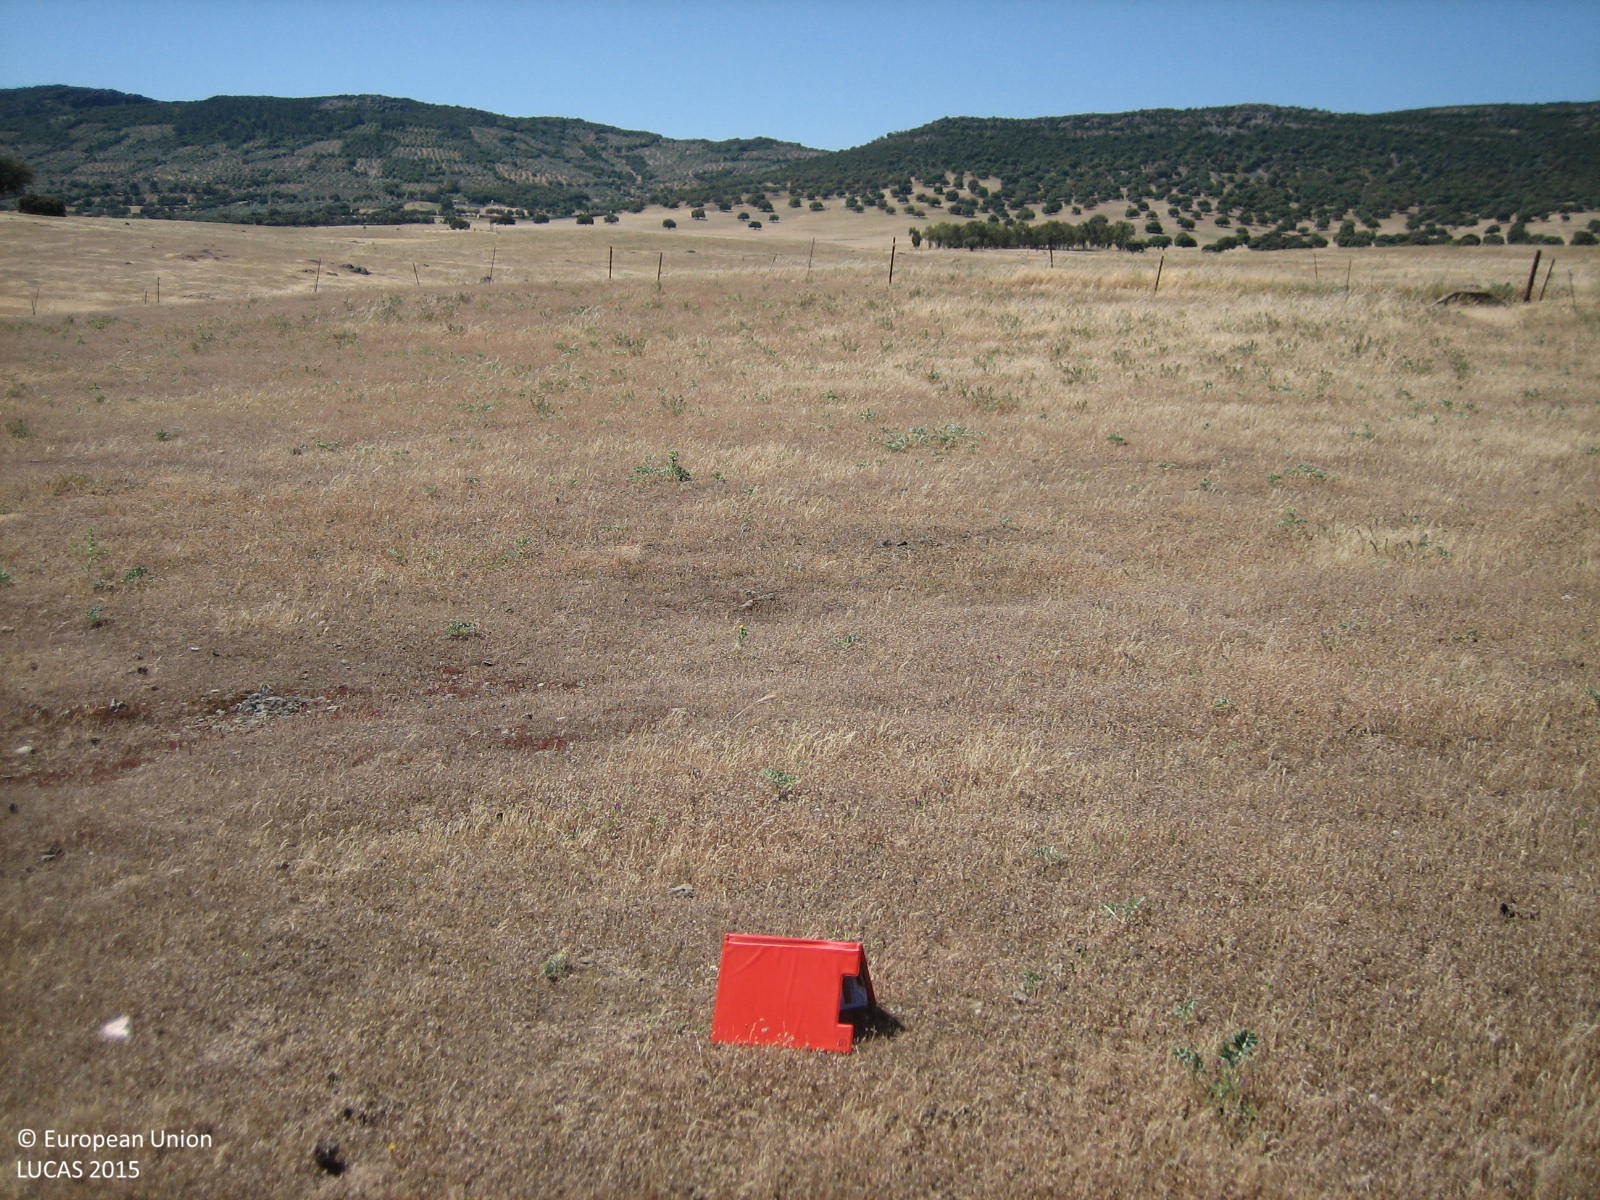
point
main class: Grassland
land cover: Spontaneously vegetated surfaces
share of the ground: > 75 %
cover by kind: herbaceous plants 100 %
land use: Agriculture (excluding fallow land and kitchen gardens)
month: May
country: ES
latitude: 38.9948
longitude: -4.8935
